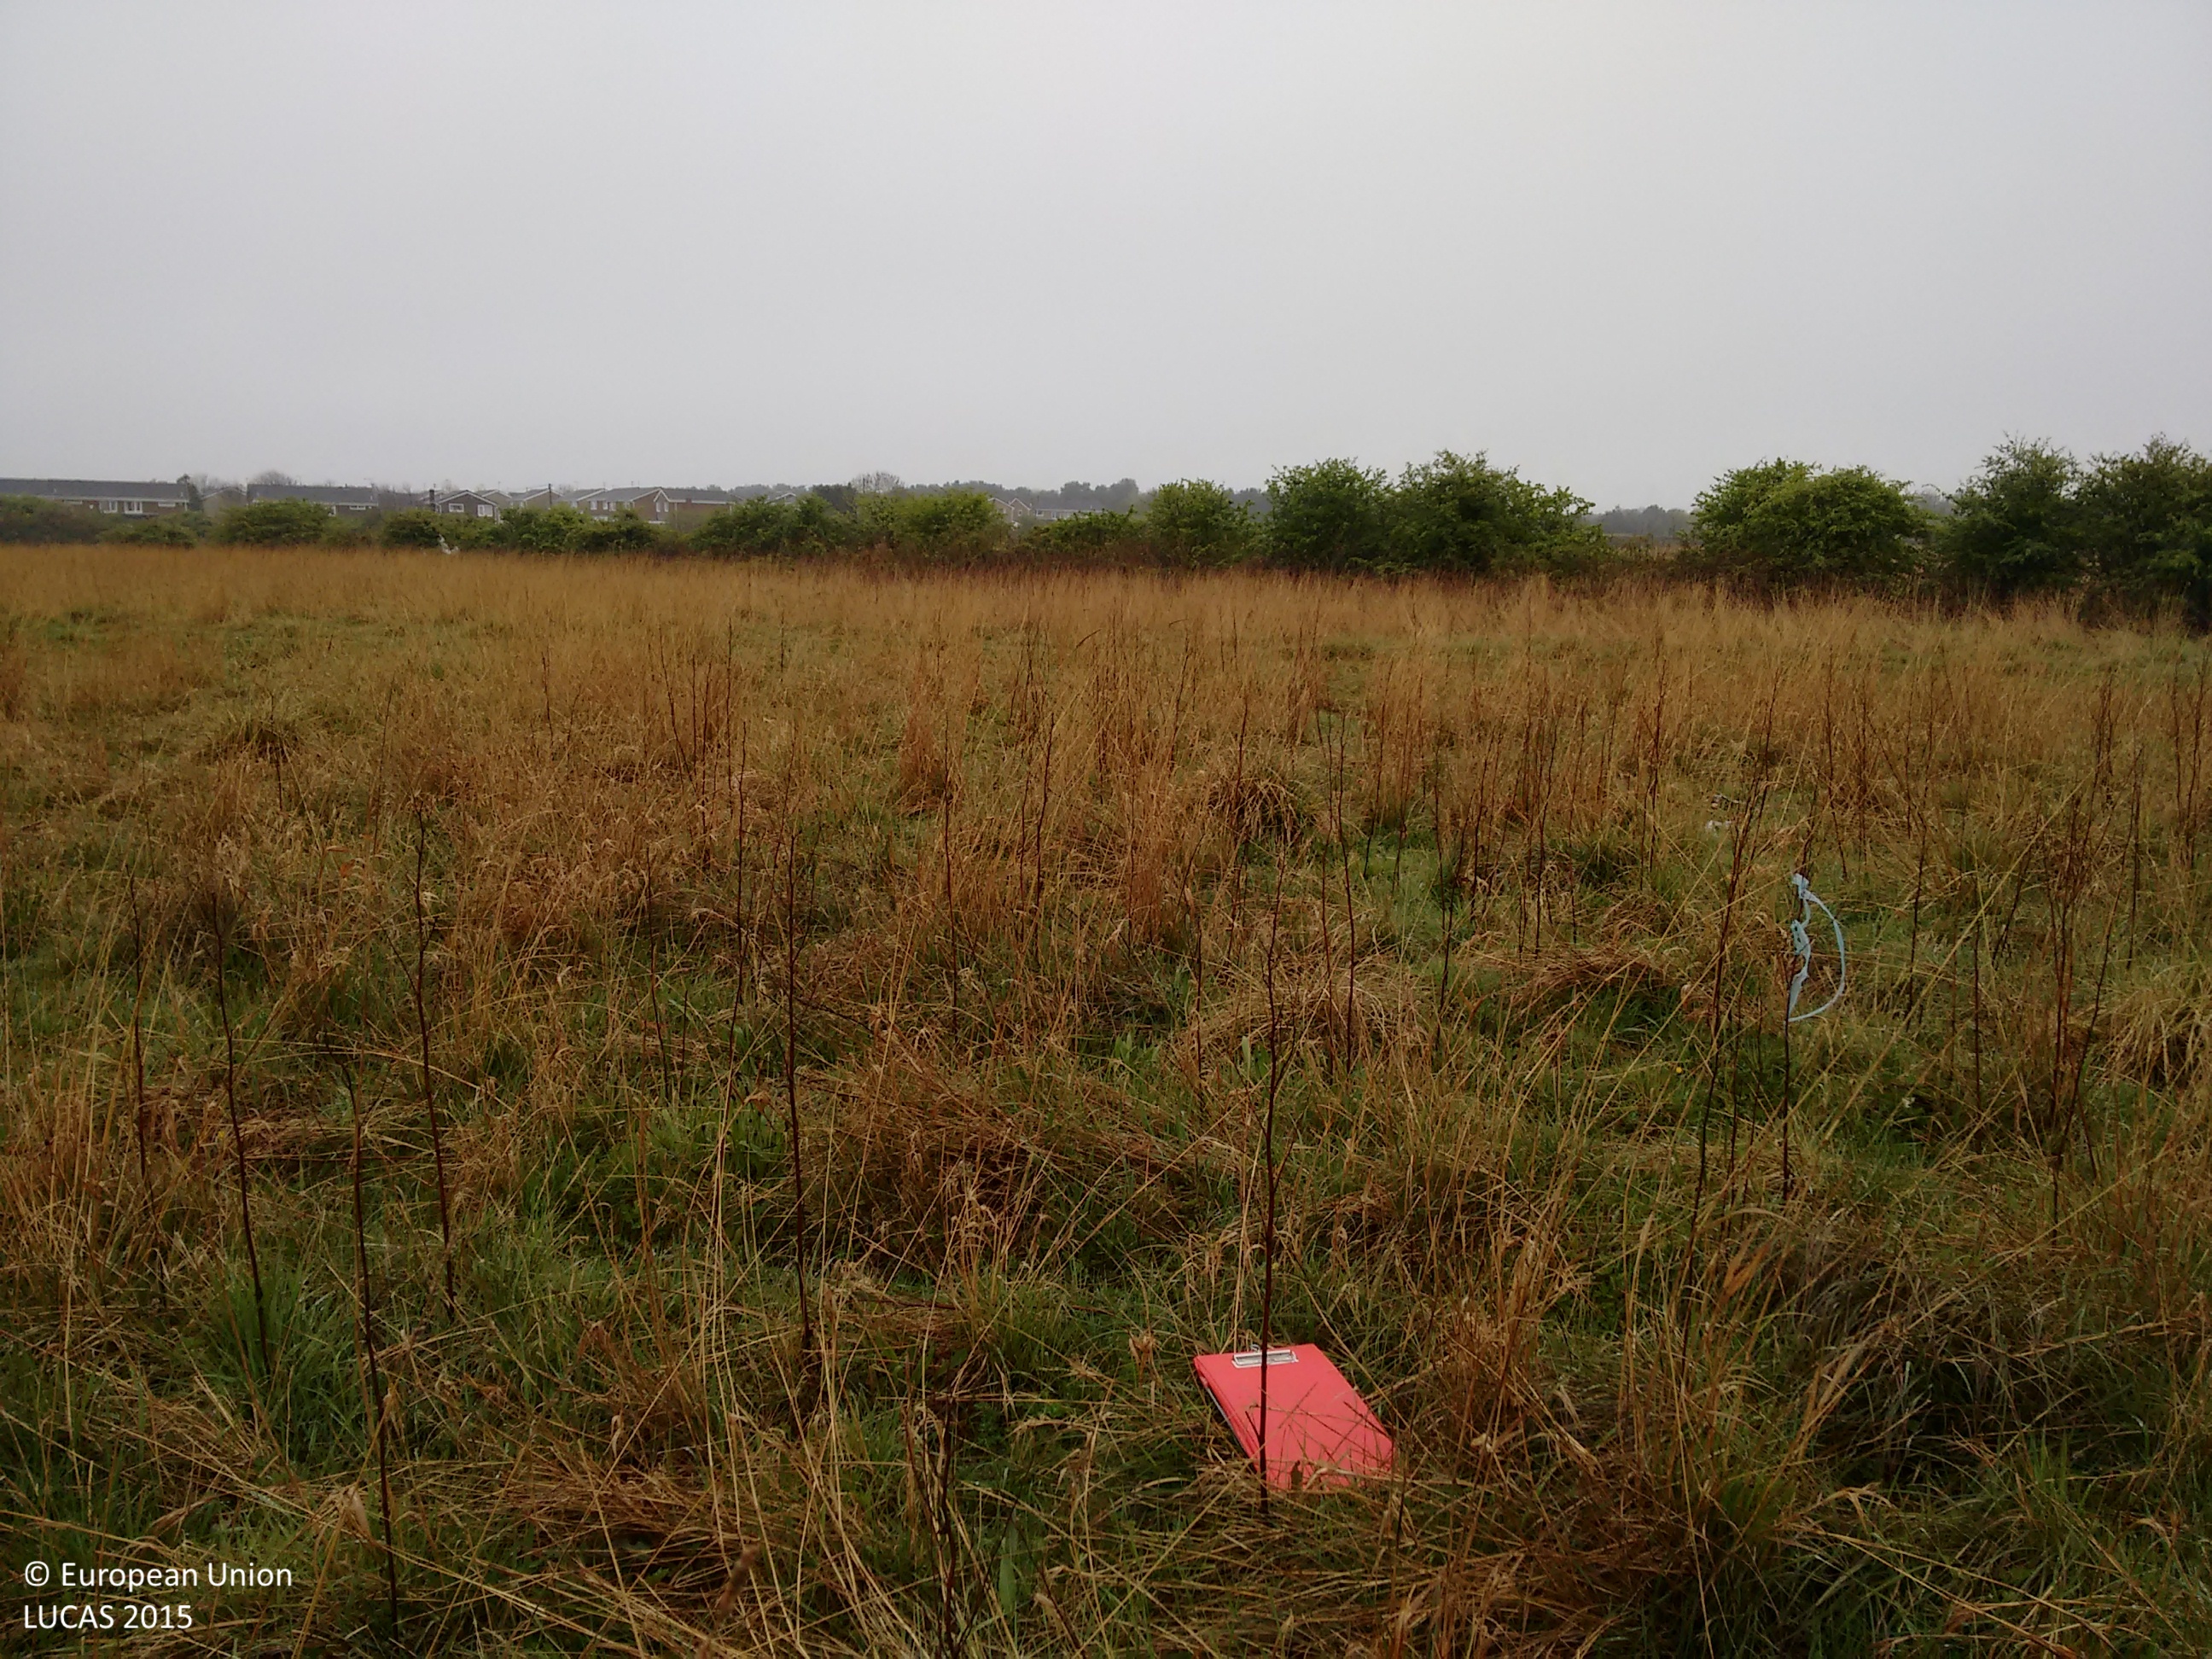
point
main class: Grassland
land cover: Grassland without tree/shrub cover
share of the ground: > 75 %
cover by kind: herbaceous plants 100 %
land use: Abandoned areas
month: May
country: GB
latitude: 55.1197
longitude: -1.5407
